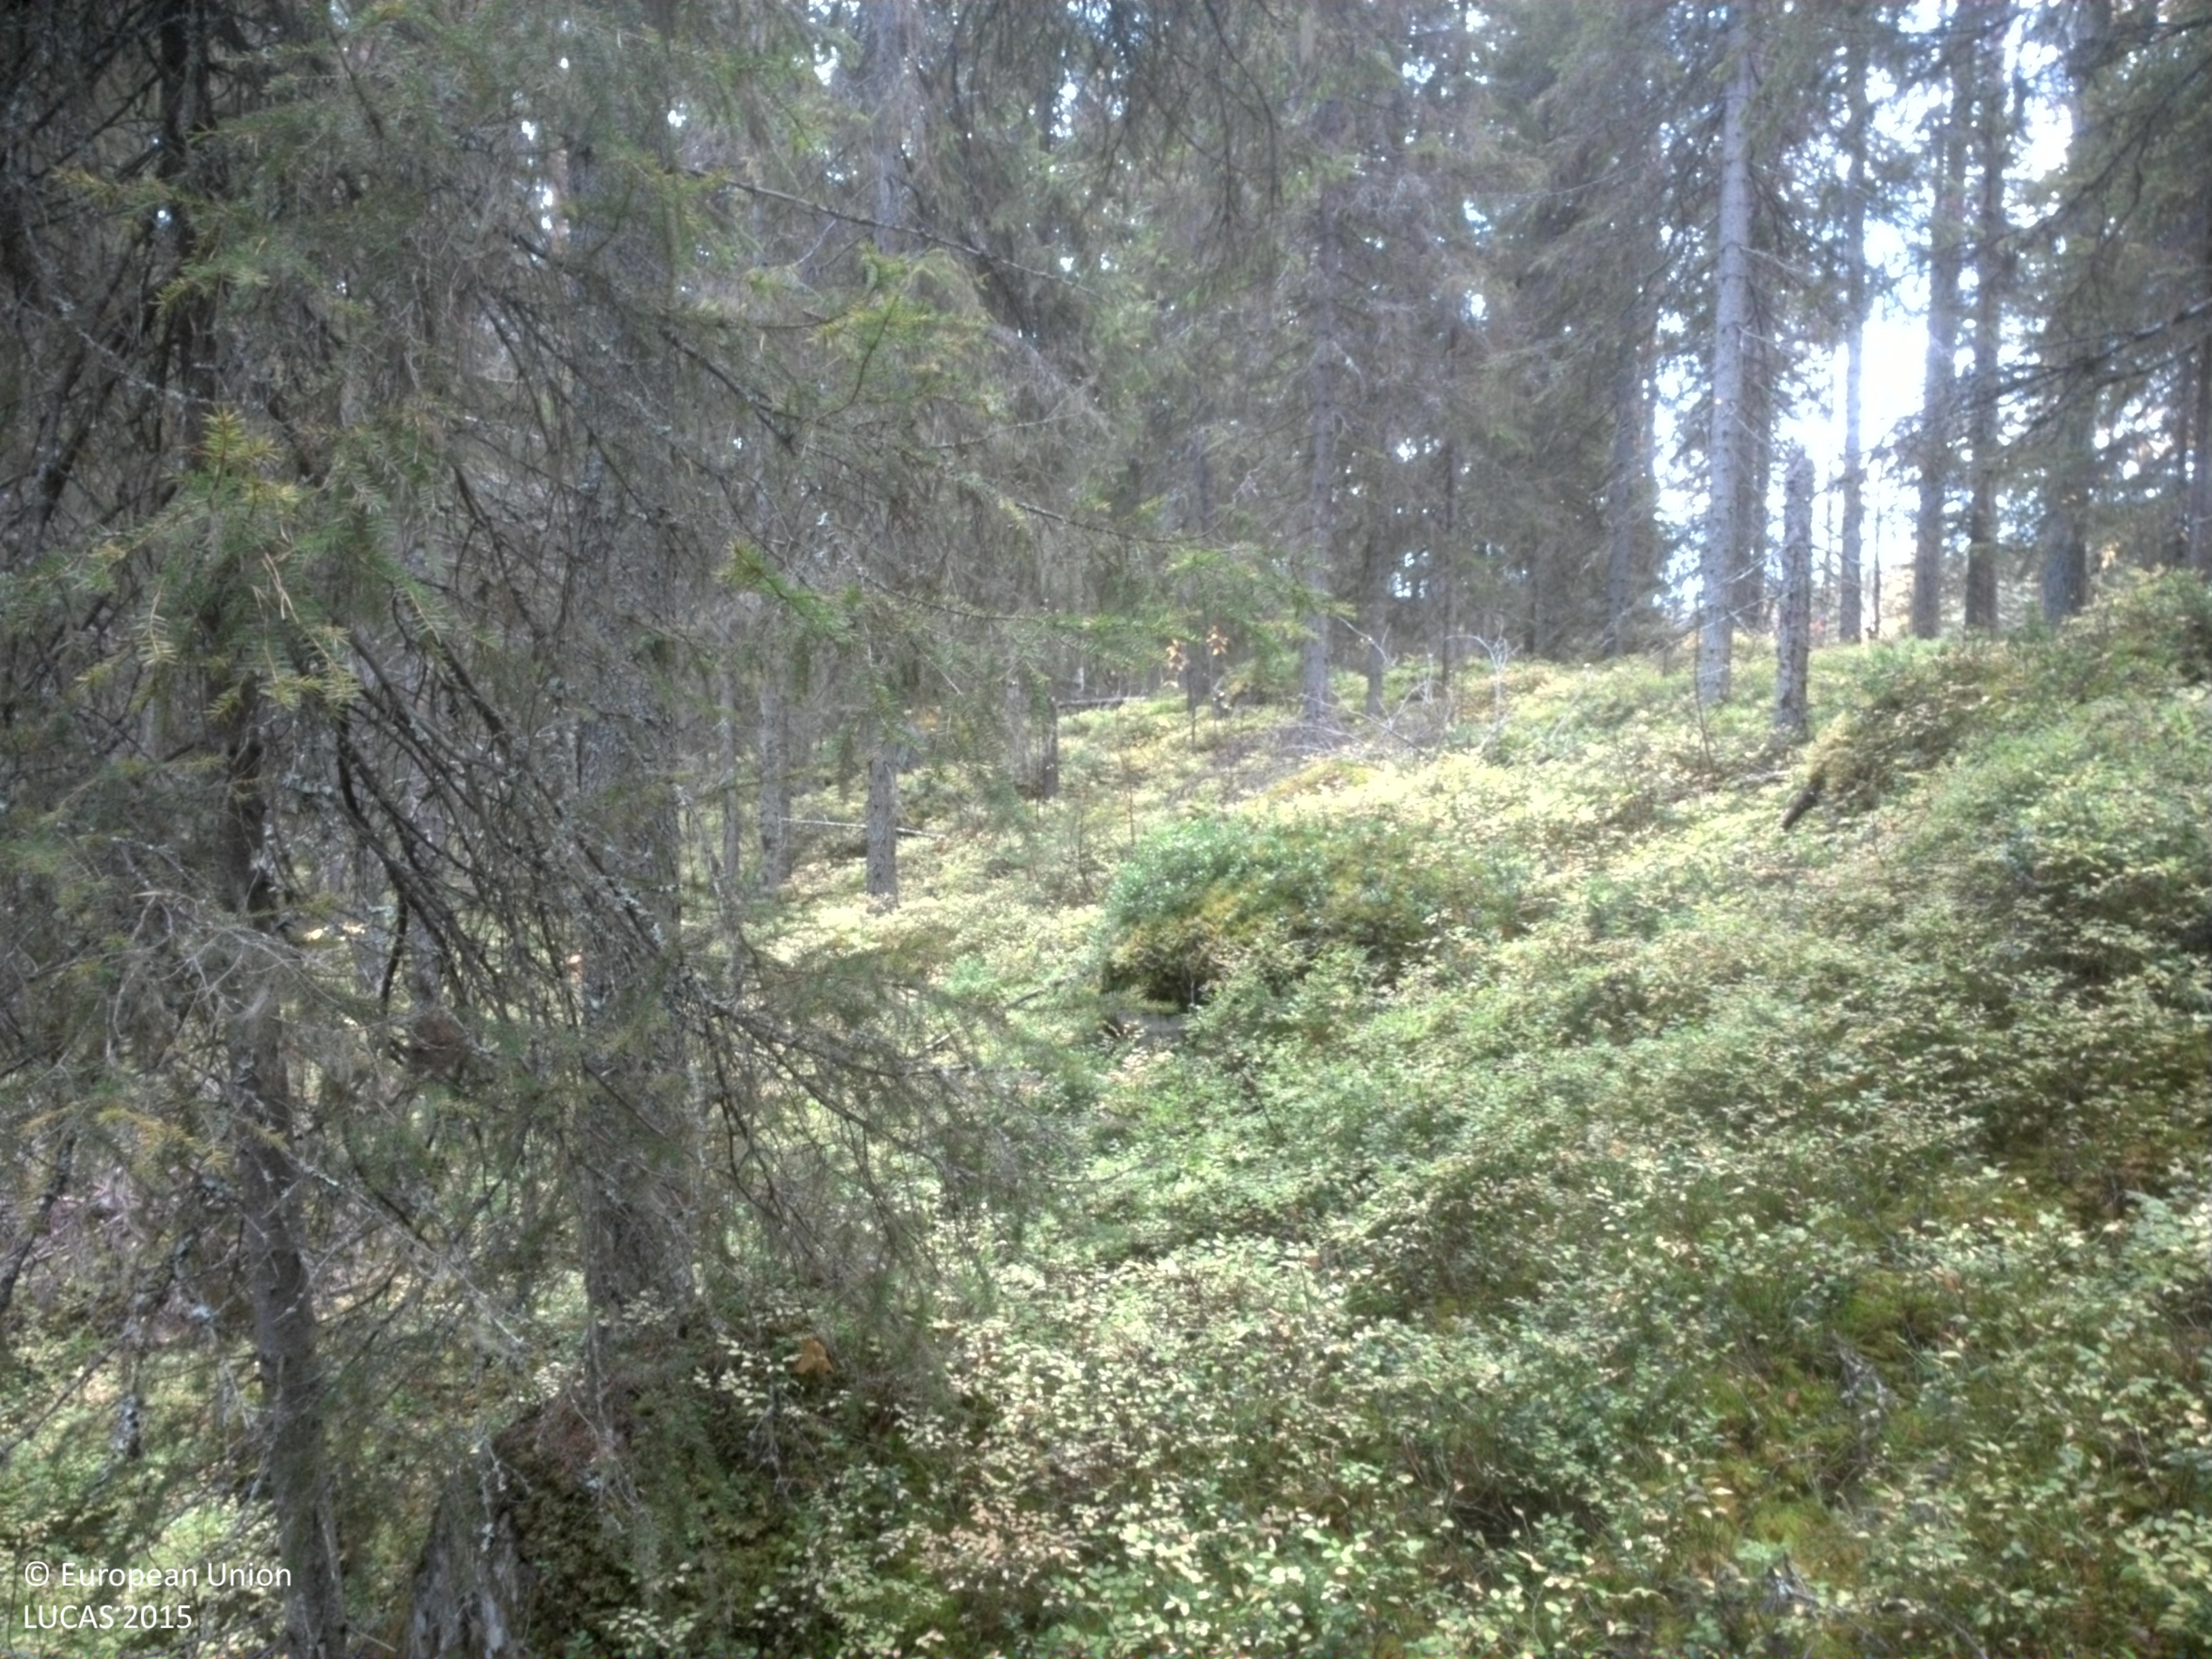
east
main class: Woodland
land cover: Spruce dominated coniferous woodland
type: boreal forest
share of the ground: 50 - 75 %
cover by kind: coniferous forest trees 60 %, shrubs 30 %, lichens and mosses 10 %
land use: Forestry
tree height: > 5 m
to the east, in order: Spruce dominated coniferous woodland; Tracks; Spruce dominated mixed woodland; Pine dominated coniferous woodland; Broadleaved woodland; Inland marshes; Inland fresh water bodies
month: September
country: SE
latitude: 64.3437
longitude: 20.1819
